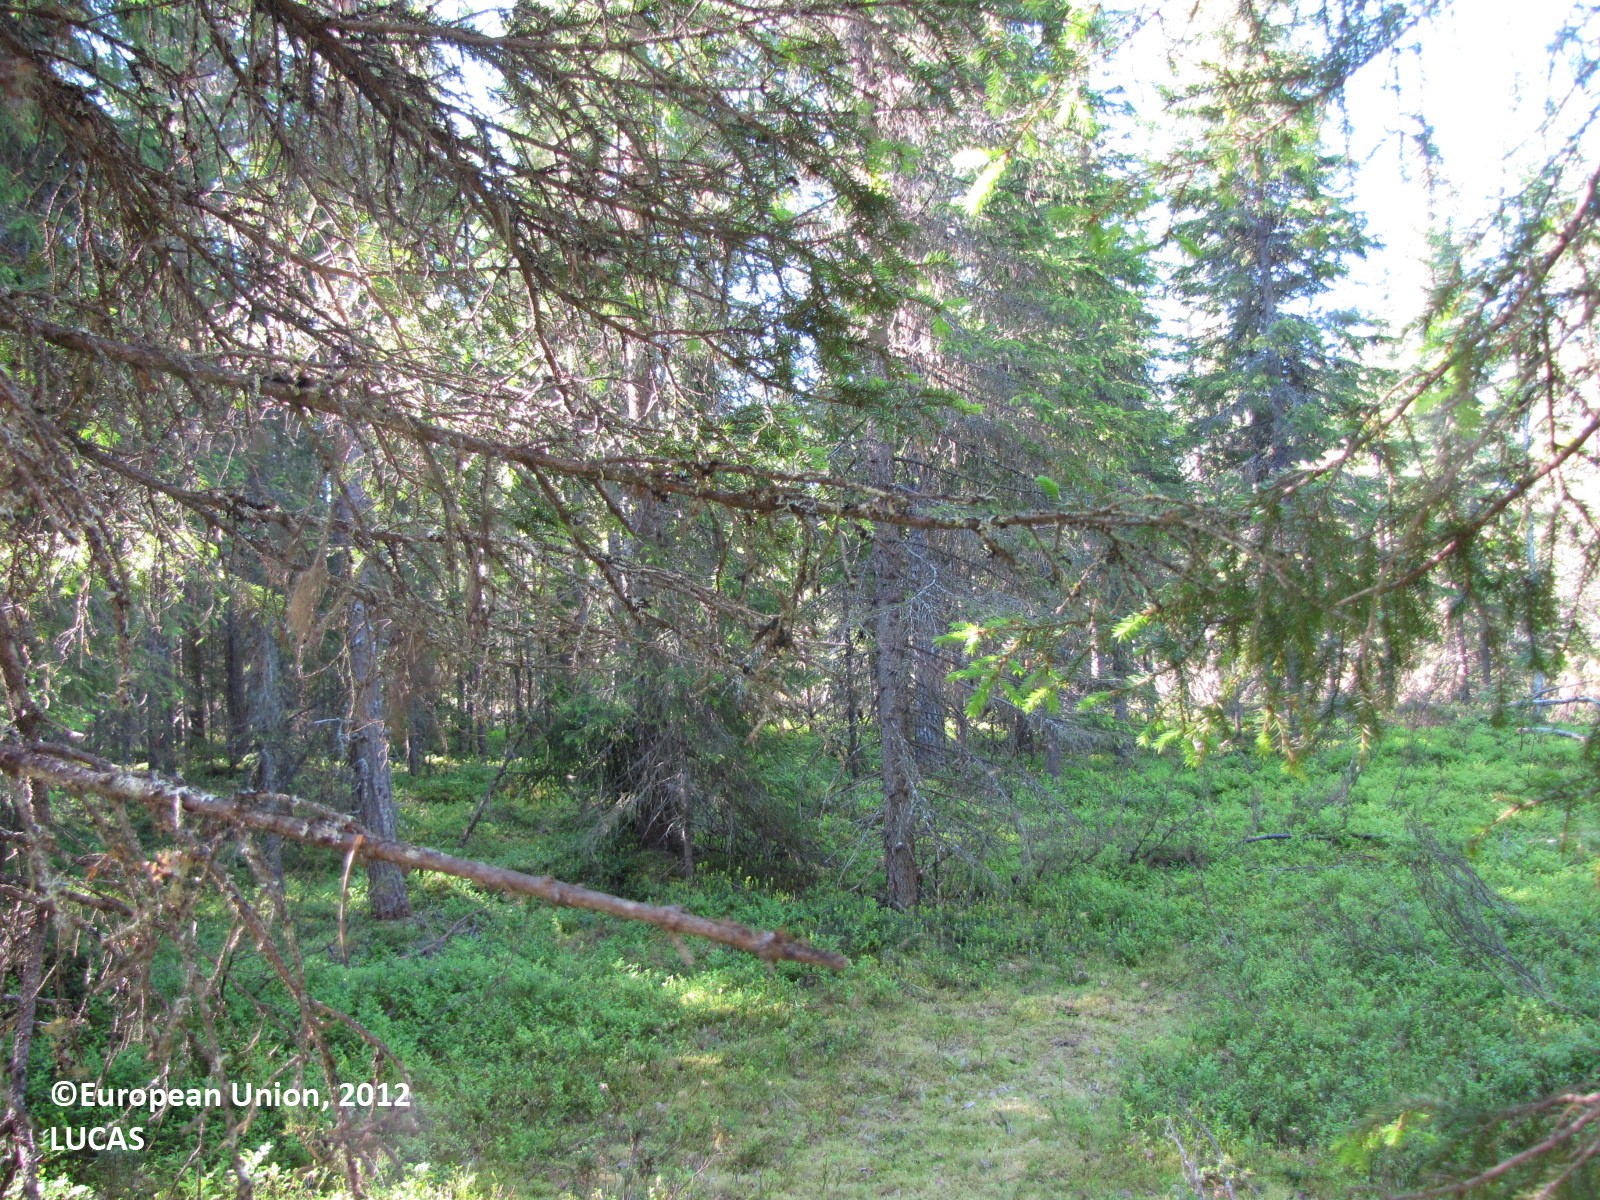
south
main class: Woodland
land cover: Spruce dominated coniferous woodland
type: boreal forest
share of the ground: 50 - 75 %
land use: Forestry
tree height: > 5 m
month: July
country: FI
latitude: 66.4170
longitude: 24.7670
